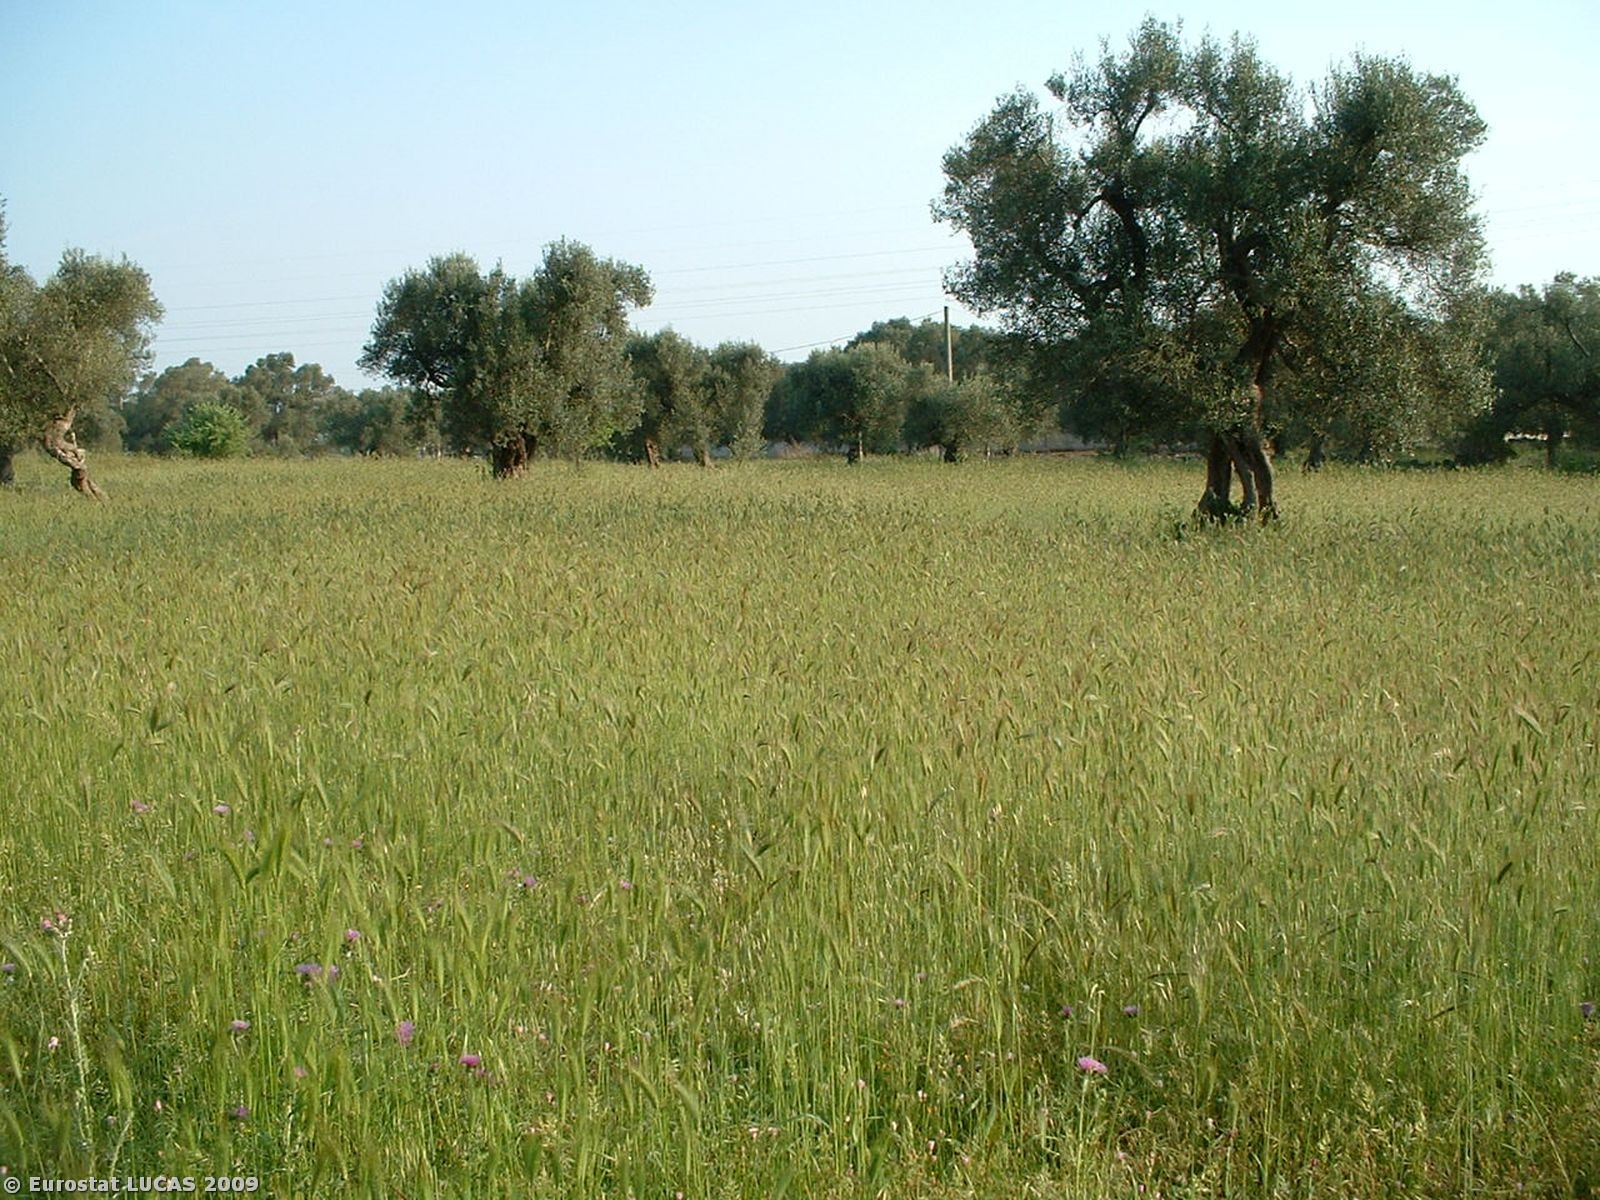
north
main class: Cropland
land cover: Olive groves
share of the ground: 10 - 25 %
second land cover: Spontaneously vegetated surfaces
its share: 50 - 75 %
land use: Agriculture (excluding fallow land and kitchen gardens)
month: May
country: IT
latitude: 40.2752
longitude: 18.1249
